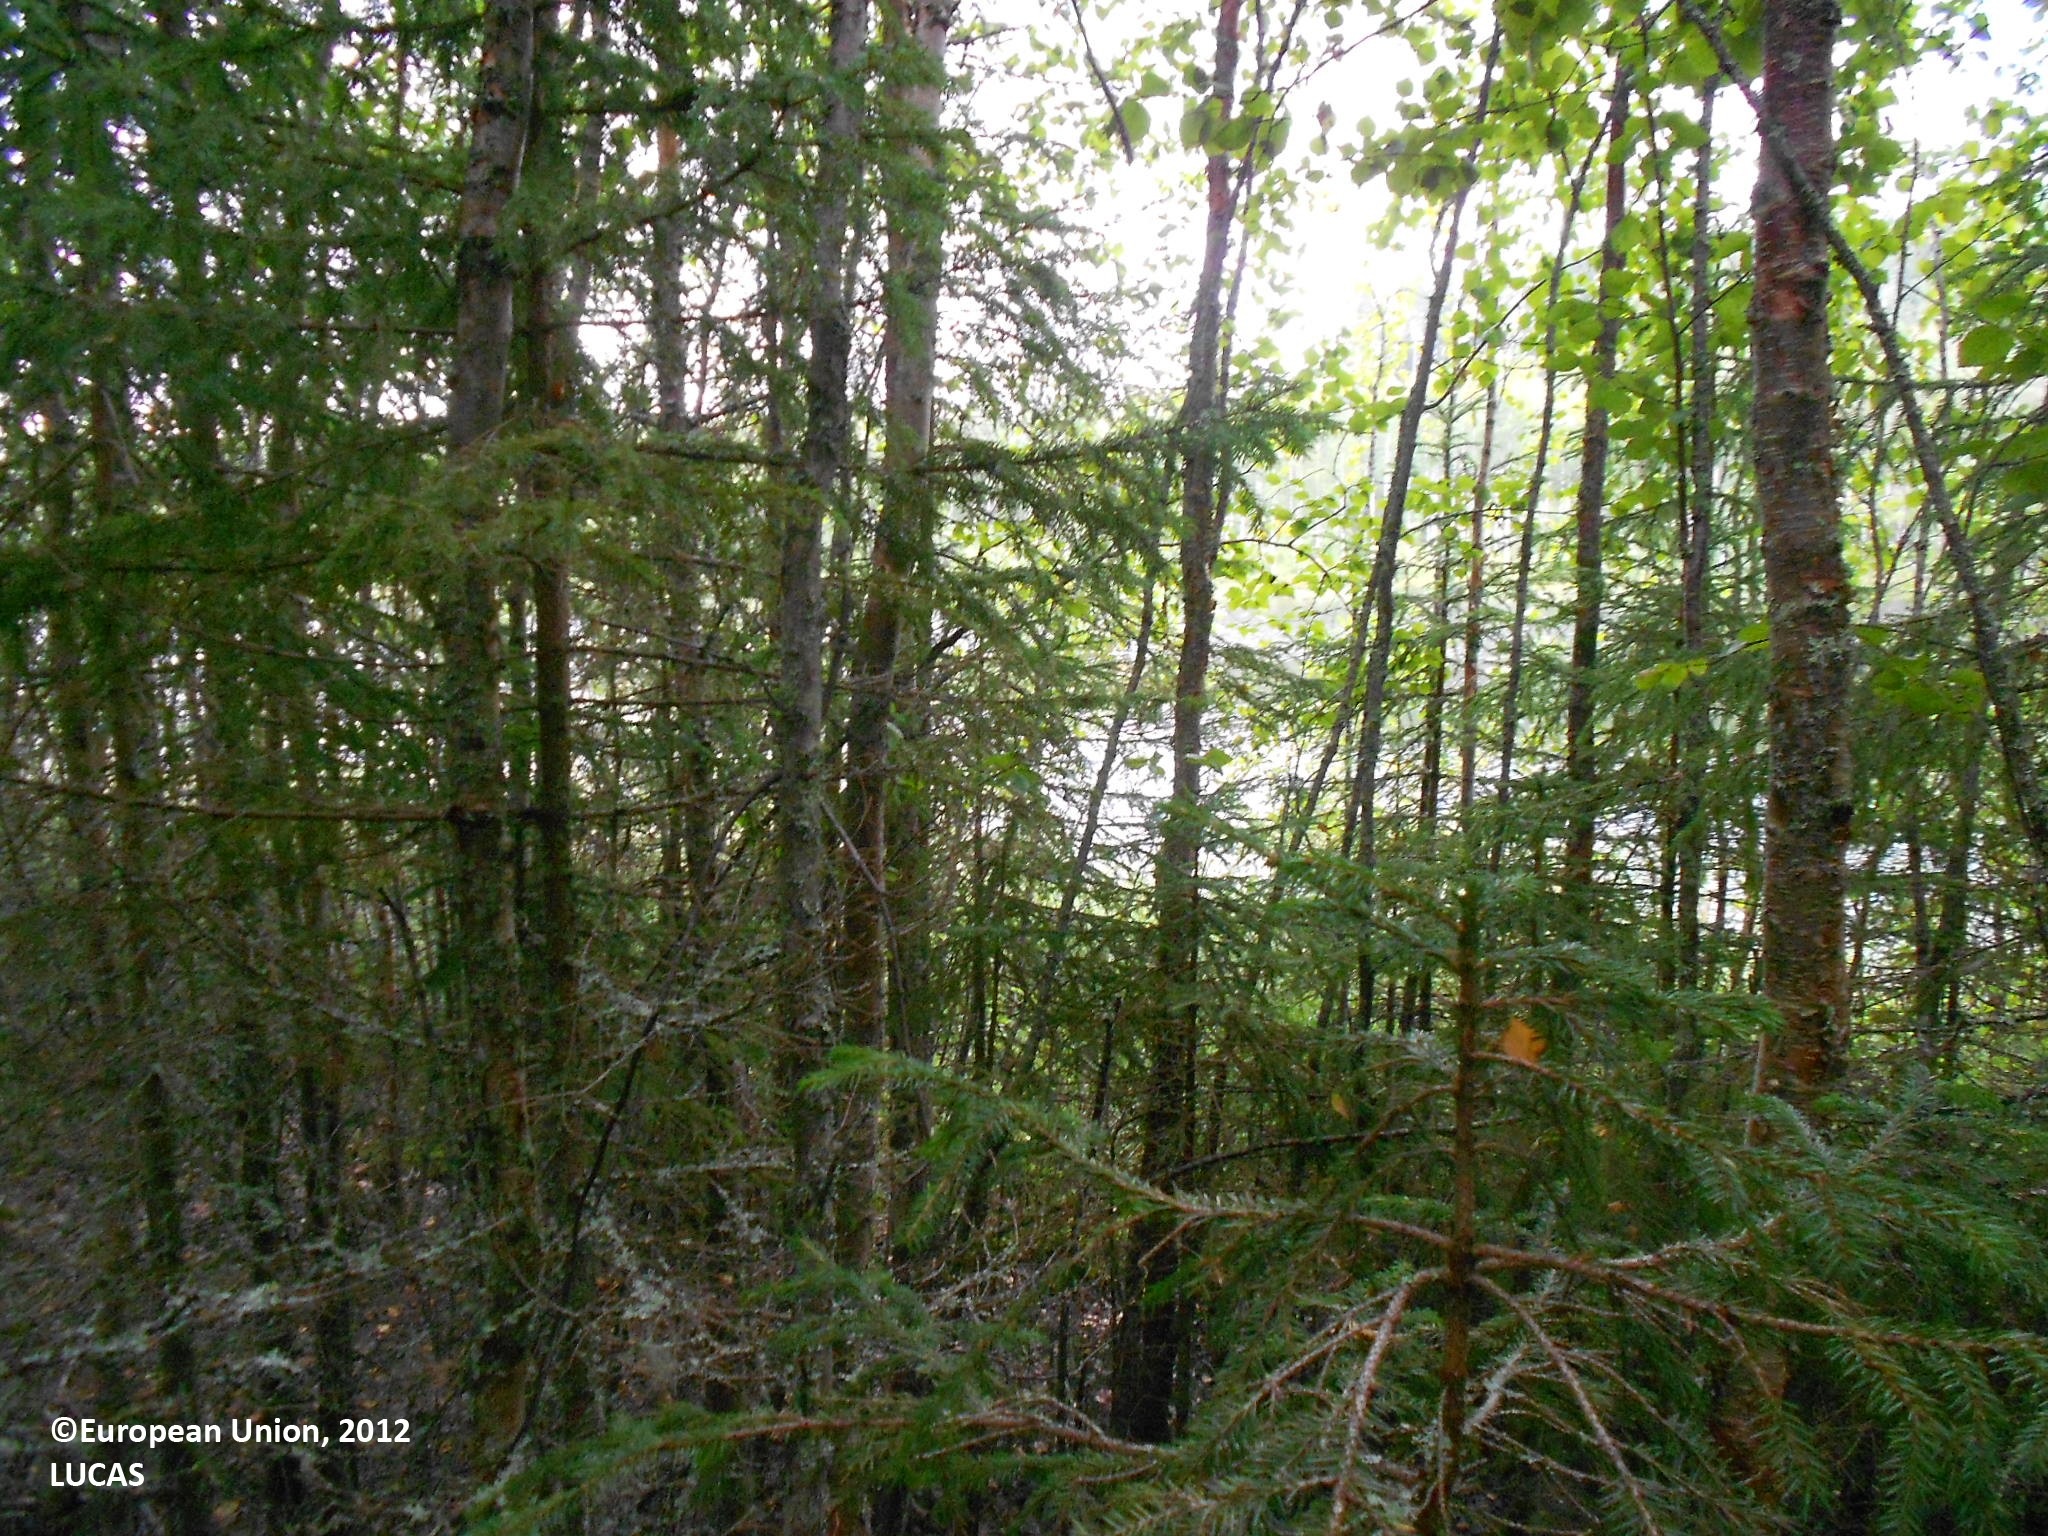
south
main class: Woodland
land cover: Spruce dominated coniferous woodland
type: boreal forest
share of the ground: > 75 %
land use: Forestry
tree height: > 5 m
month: August
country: FI
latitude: 63.5318
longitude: 28.8435
